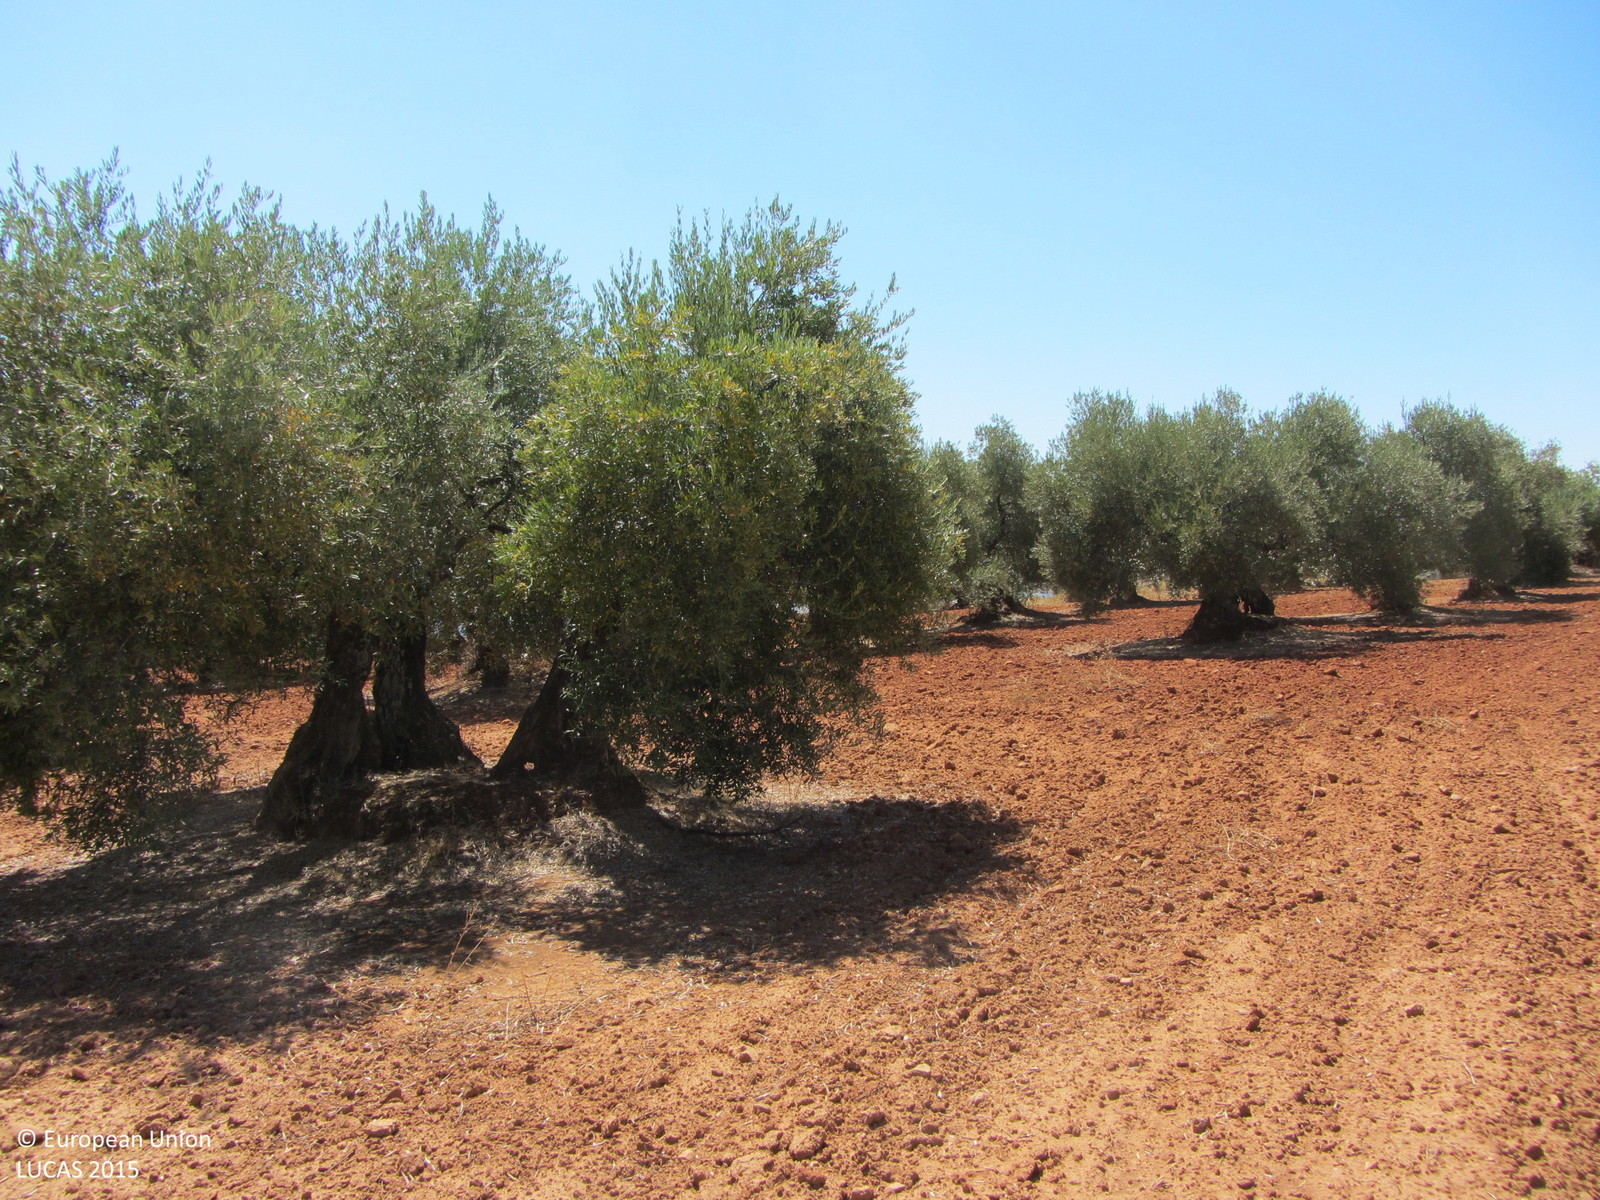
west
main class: Cropland
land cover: Olive groves
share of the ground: 25 - 50 %
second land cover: Other bare soil
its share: > 75 %
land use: Agriculture (excluding fallow land and kitchen gardens)
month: July
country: ES
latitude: 38.0688
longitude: -4.2244
